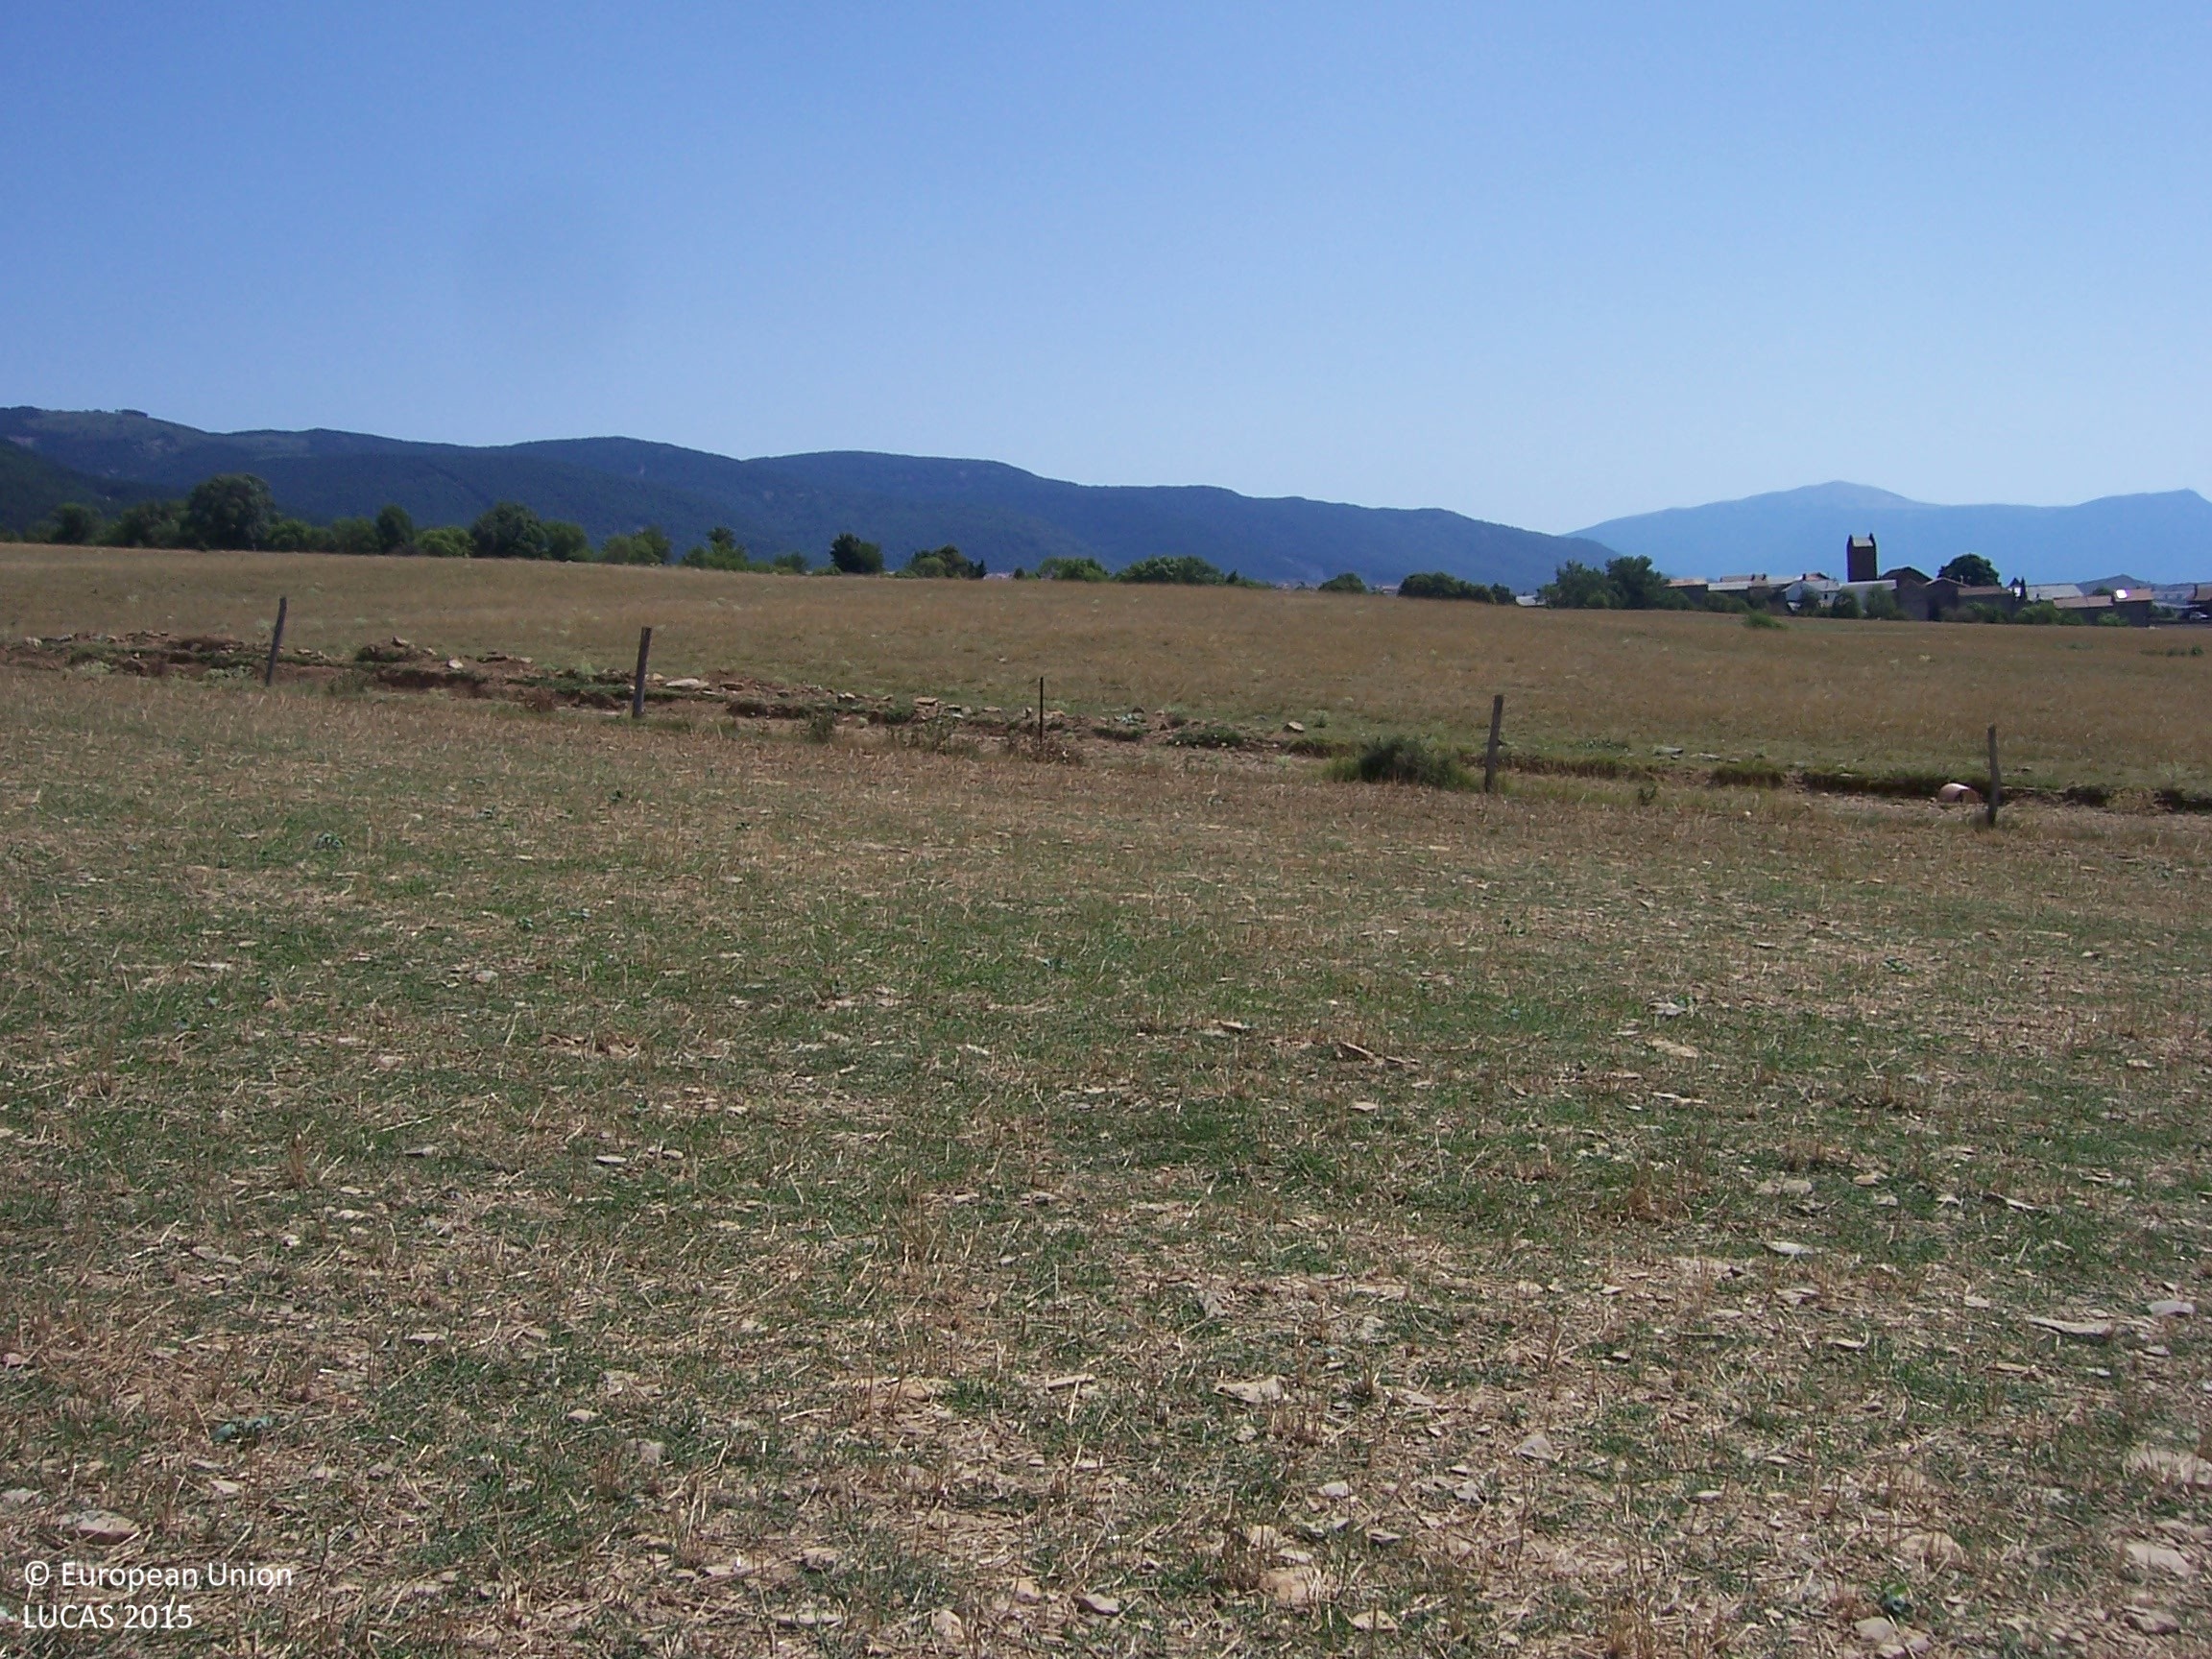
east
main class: Grassland
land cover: Grassland without tree/shrub cover
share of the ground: 50 - 75 %
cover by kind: herbaceous plants 60 %, unconsolidated bare surface 40 %
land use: Agriculture (excluding fallow land and kitchen gardens)
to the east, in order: Grassland without tree/shrub cover; Fences; Grass margins; Tracks; Grass margins; Grassland without tree/shrub cover
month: August
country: ES
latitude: 42.5806
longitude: -0.4930
